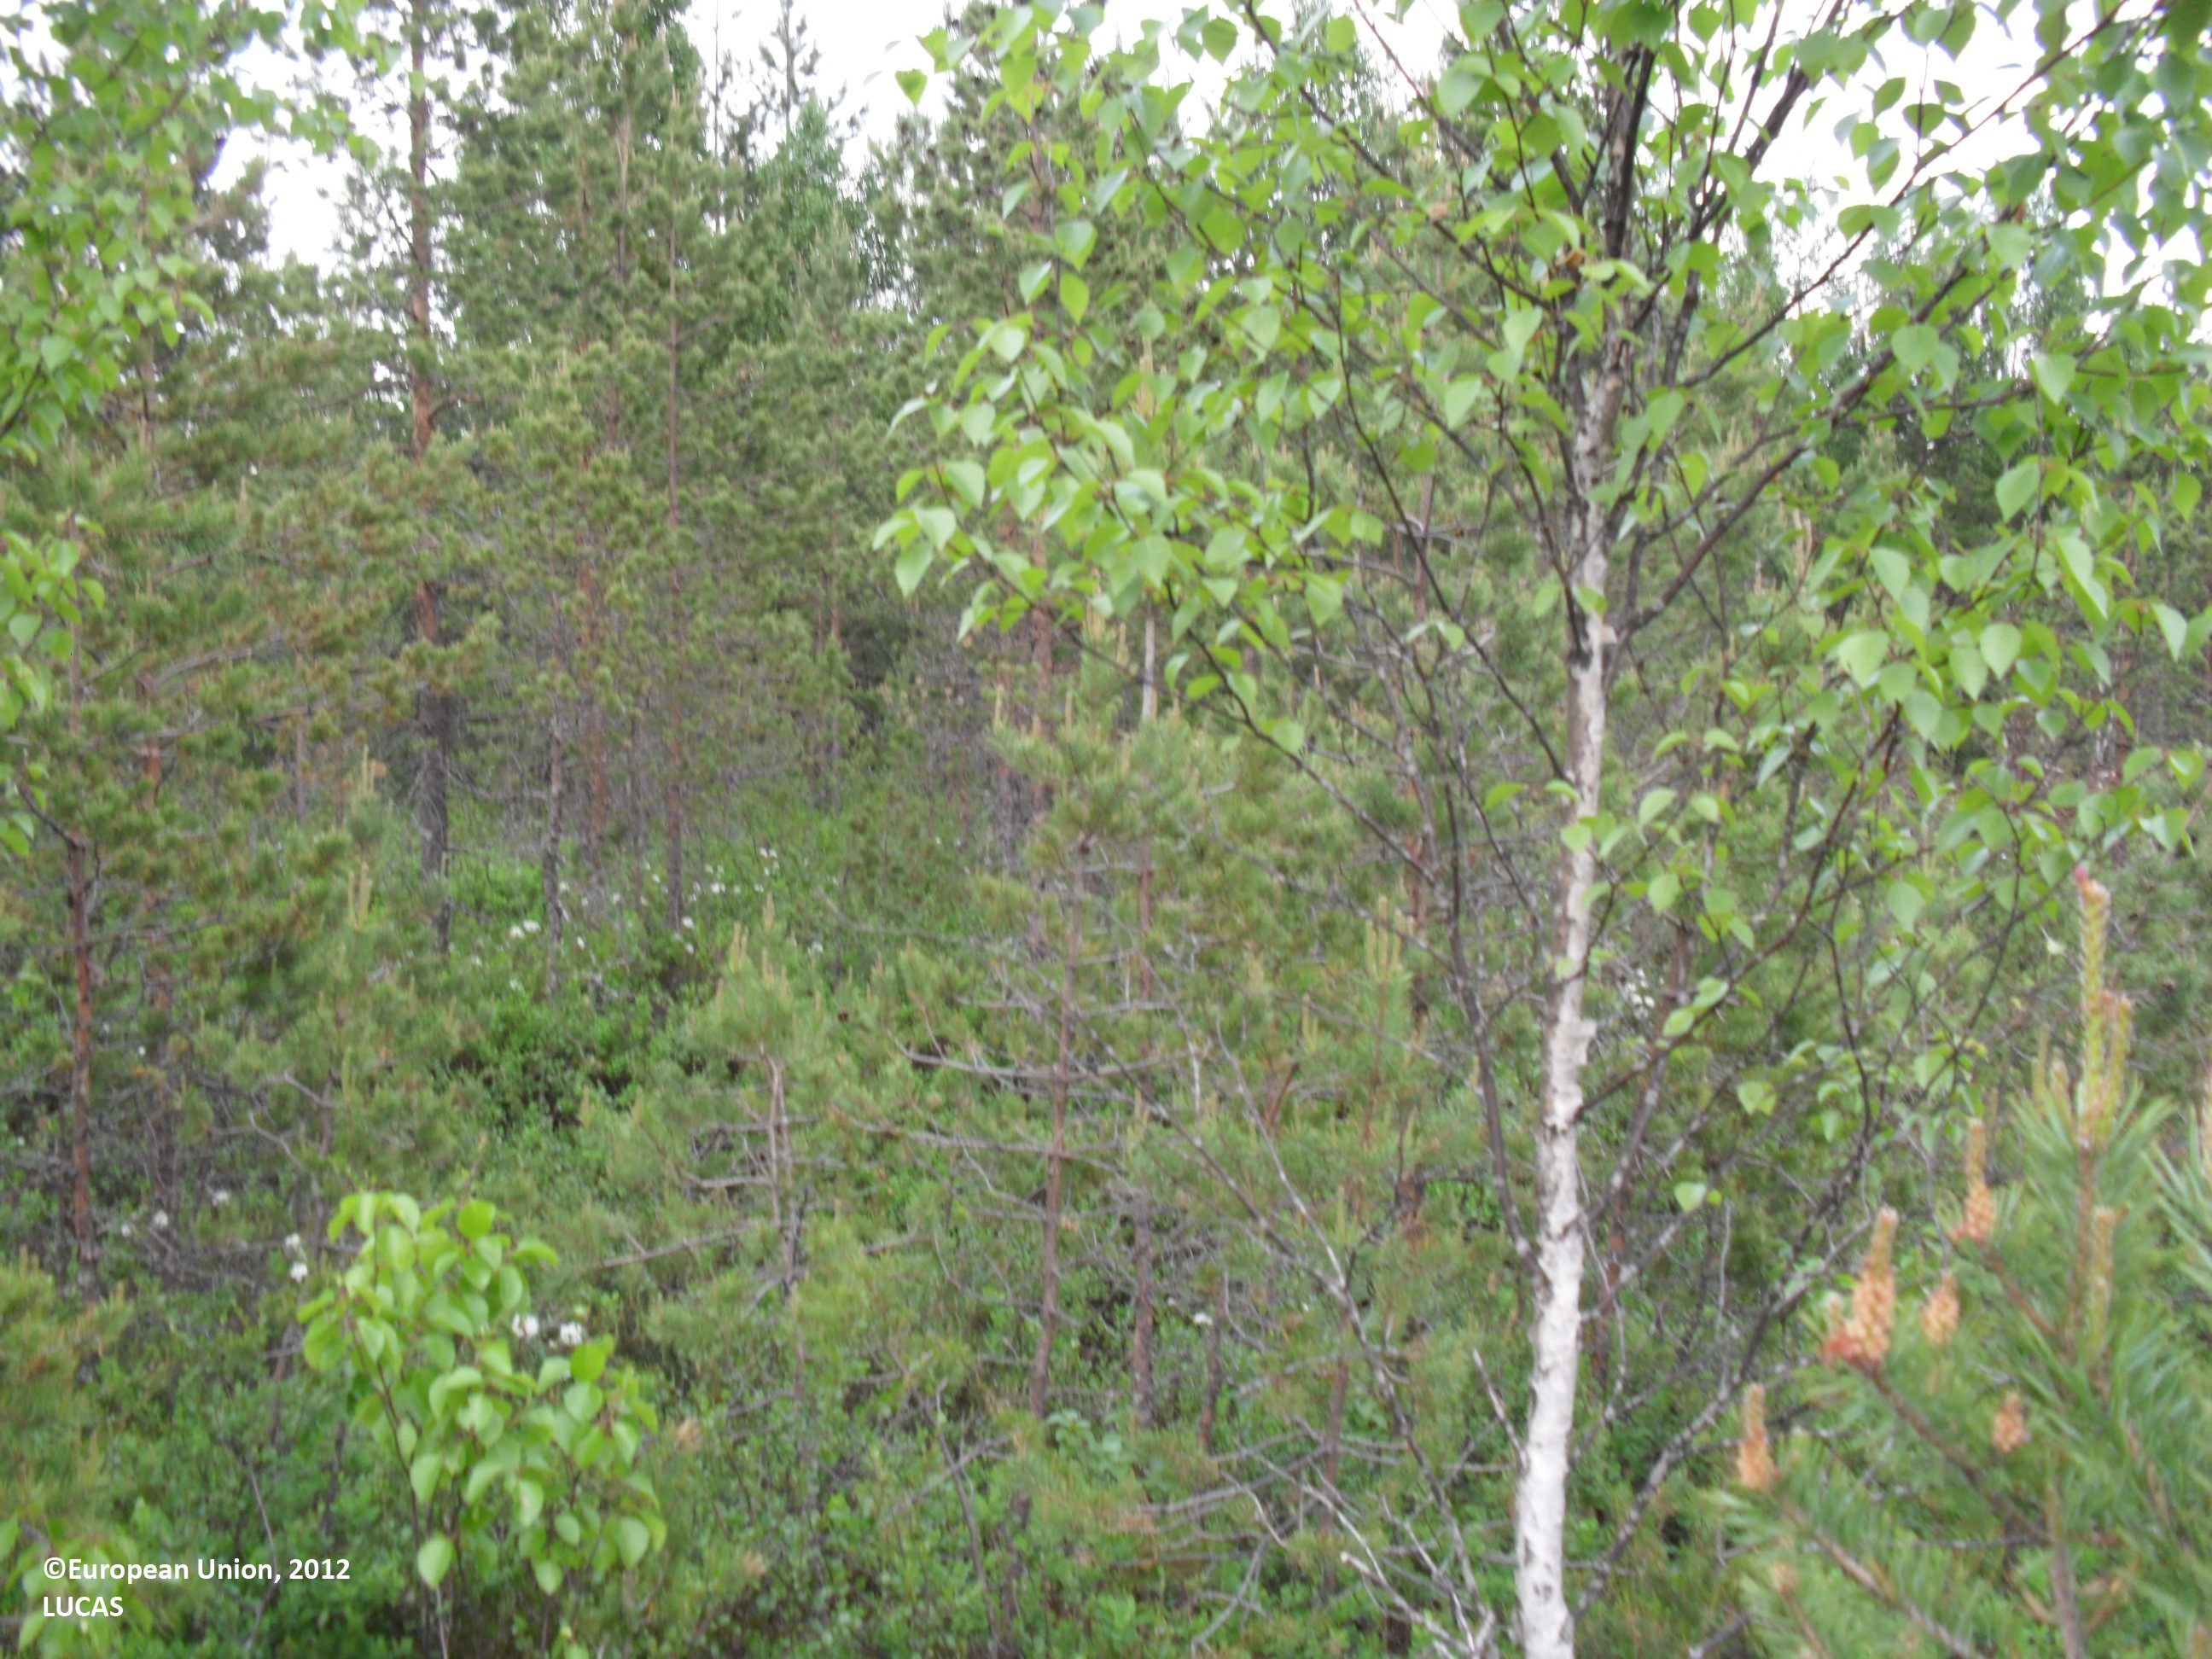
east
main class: Woodland
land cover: Pine dominated mixed woodland
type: mire and swamp forests
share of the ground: 10 - 25 %
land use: Forestry
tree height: < 5 m
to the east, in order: Pine dominated mixed woodland; Ditches and canals; Other mixed woodland; Ditches and canals; Pine dominated coniferous woodland; Ditches and canals; Pine dominated coniferous woodland; Ditches and canals; Other mixed woodland; Ditches and canals; Other mixed woodland; Ditches and canals; Other mixed woodland; Ditches and canals; Grassland with sparse tree/shrub cover; Spontaneously vegetated surfaces
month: June
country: FI
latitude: 62.9977
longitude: 23.4309
